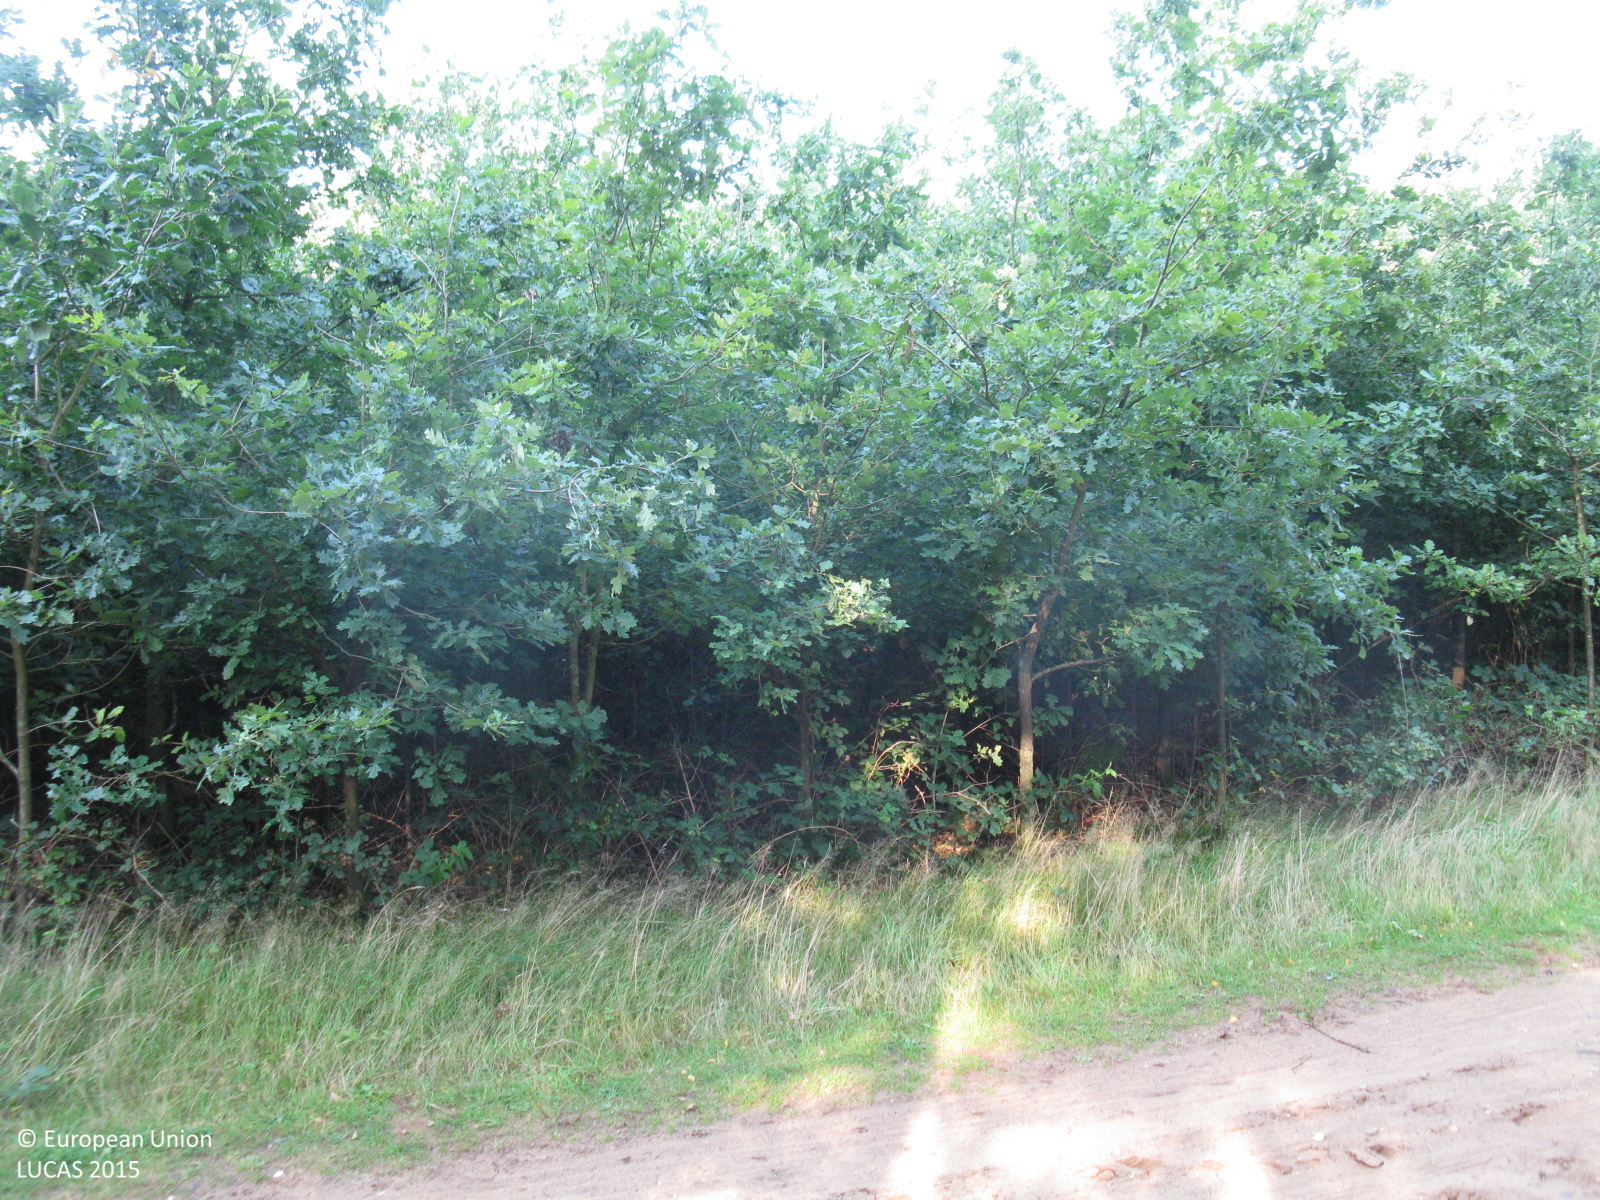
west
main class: Woodland
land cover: Pine dominated mixed woodland
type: hemiboreal forest and nemoral coniferous forest and mixed broadleaved-coniferous forest
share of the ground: > 75 %
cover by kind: coniferous forest trees 50 %, broadleaved forest trees 50 %
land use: Forestry
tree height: > 5 m
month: August
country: DE
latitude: 51.8523
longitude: 6.9367
